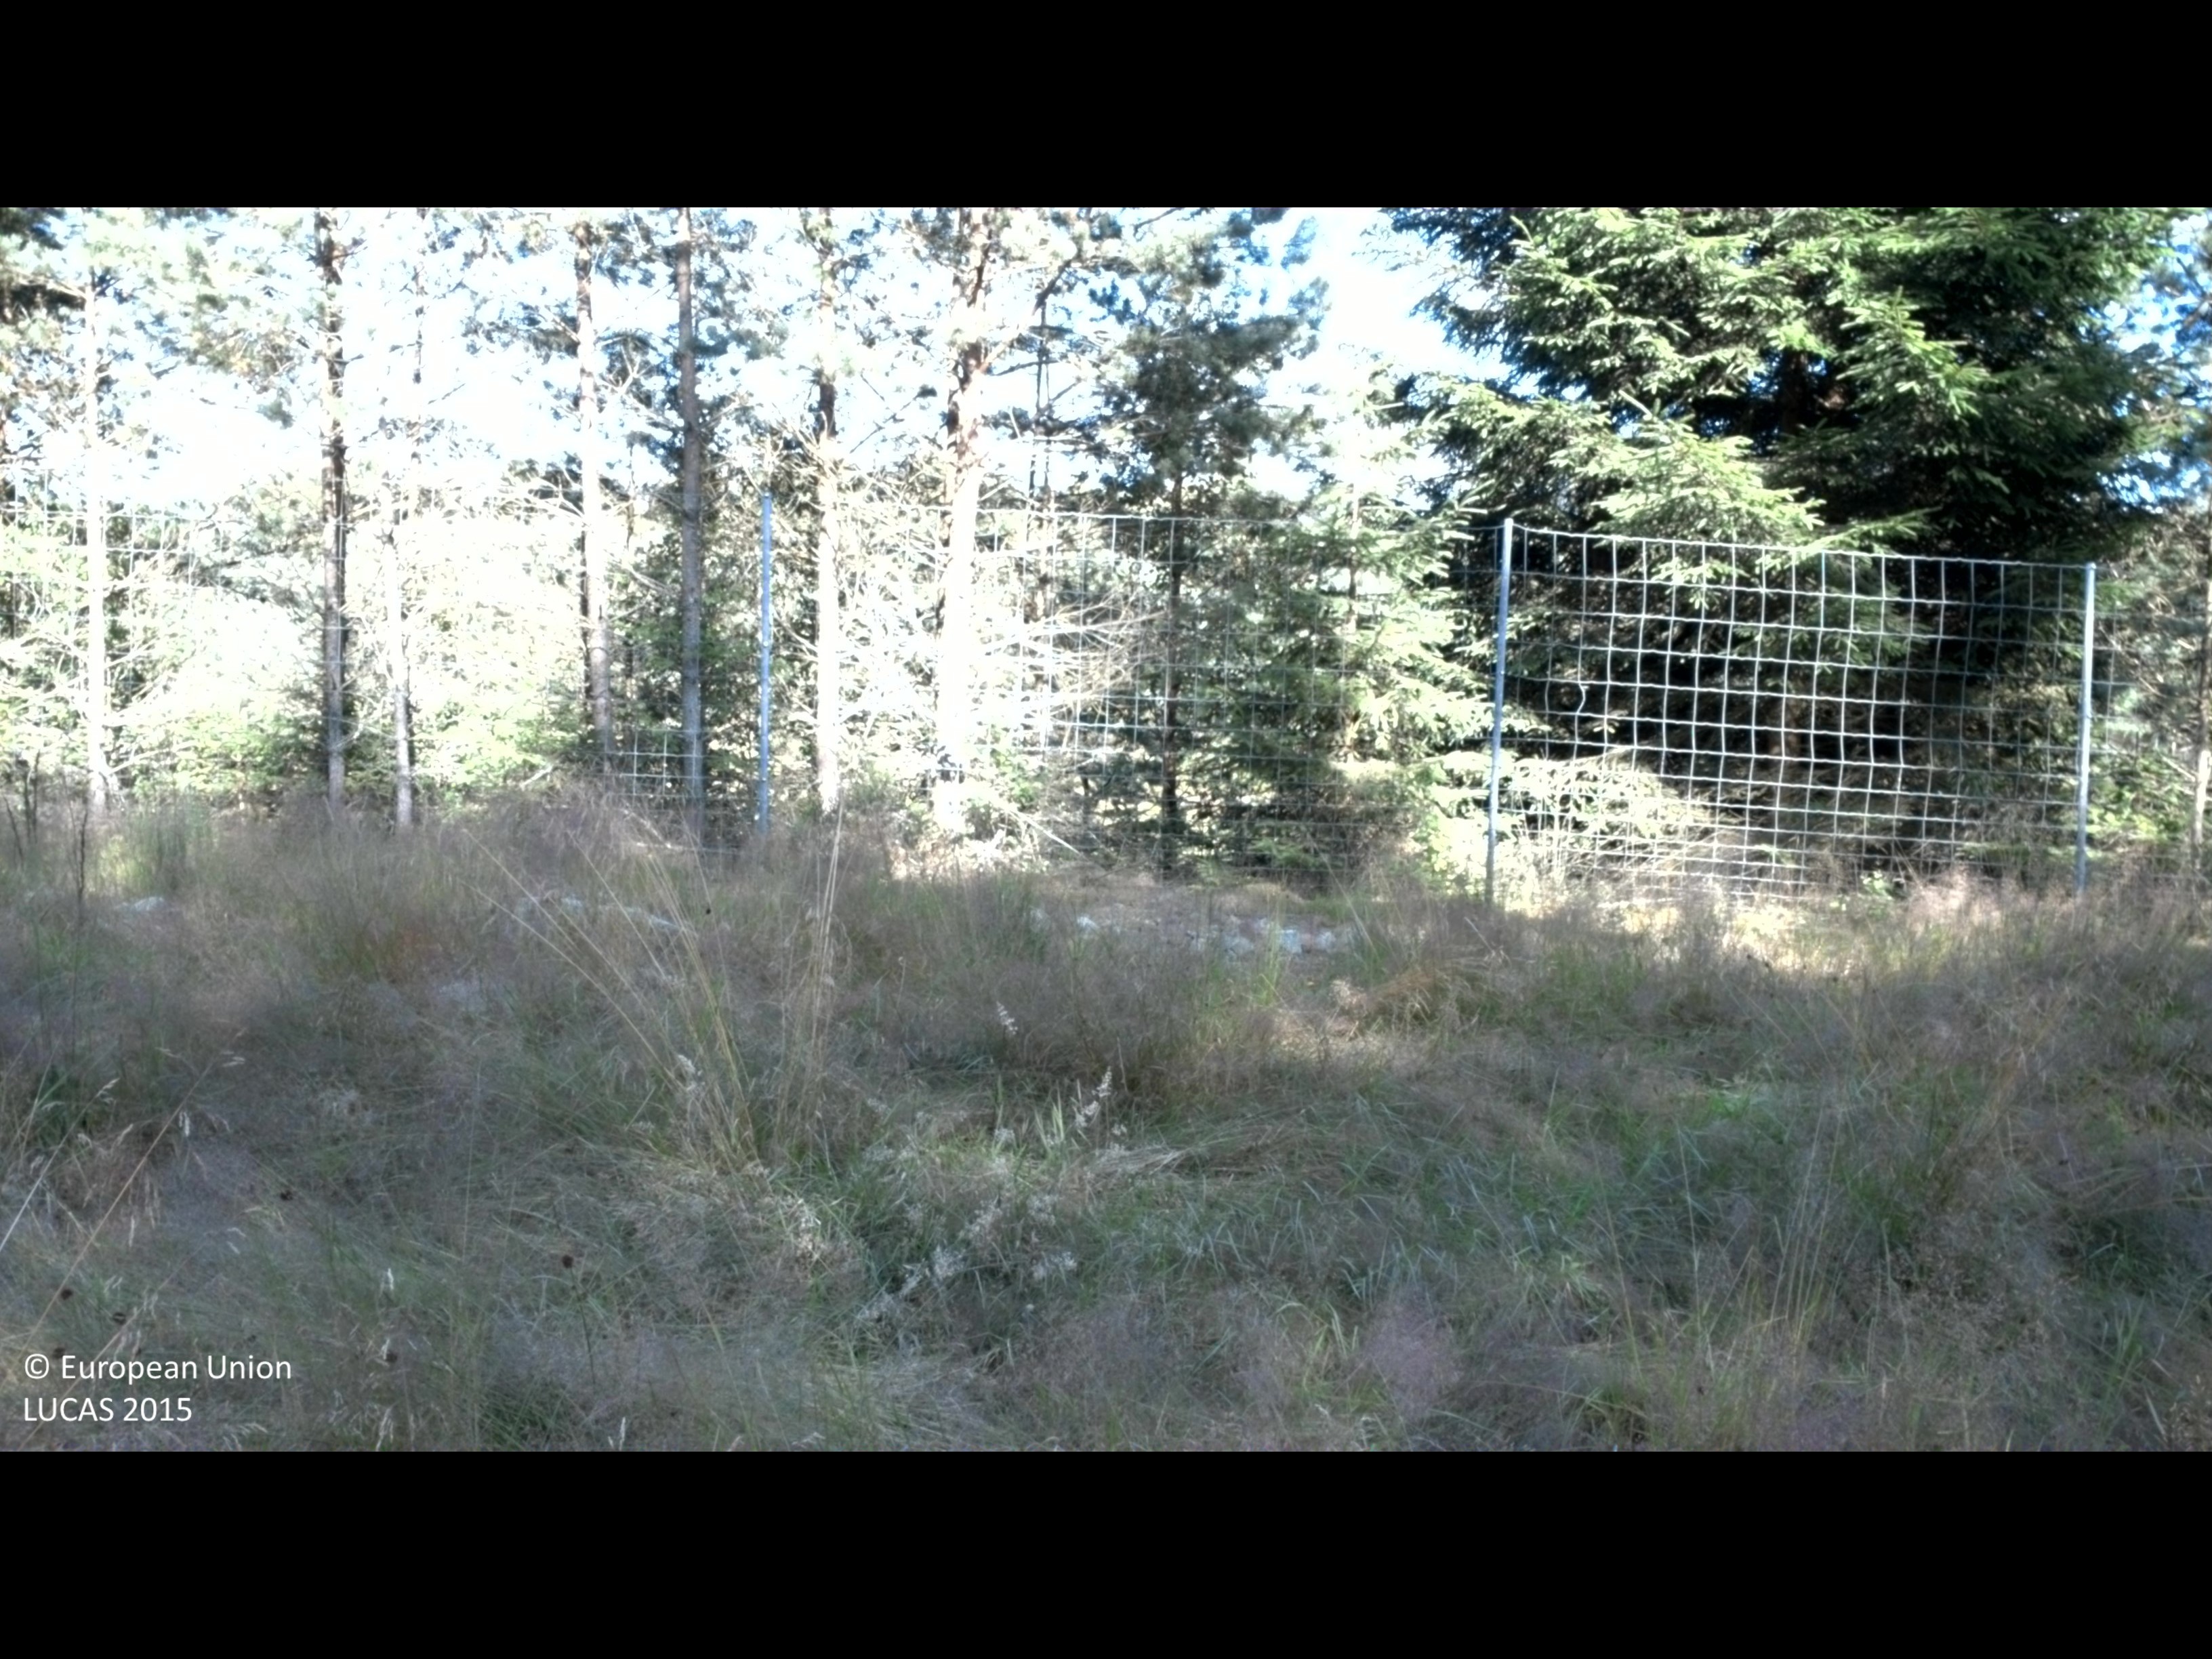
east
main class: Grassland
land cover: Grassland without tree/shrub cover
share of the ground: > 75 %
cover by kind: herbaceous plants 90 %, unconsolidated bare surface 10 %
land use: Forestry
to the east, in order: Grassland without tree/shrub cover; Fences; Pine dominated coniferous woodland; Grass margins; Paved roads, cycling and walking lanes; Grass margins; Broadleaved woodland; Paved roads, cycling and walking lanes; Fences; Pine dominated mixed woodland; Spruce dominated mixed woodland; Shrubland with sparse tree cover; Spruce dominated mixed woodland; Grassland with sparse tree/shrub cover
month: August
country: SE
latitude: 56.6885
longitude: 13.8335
